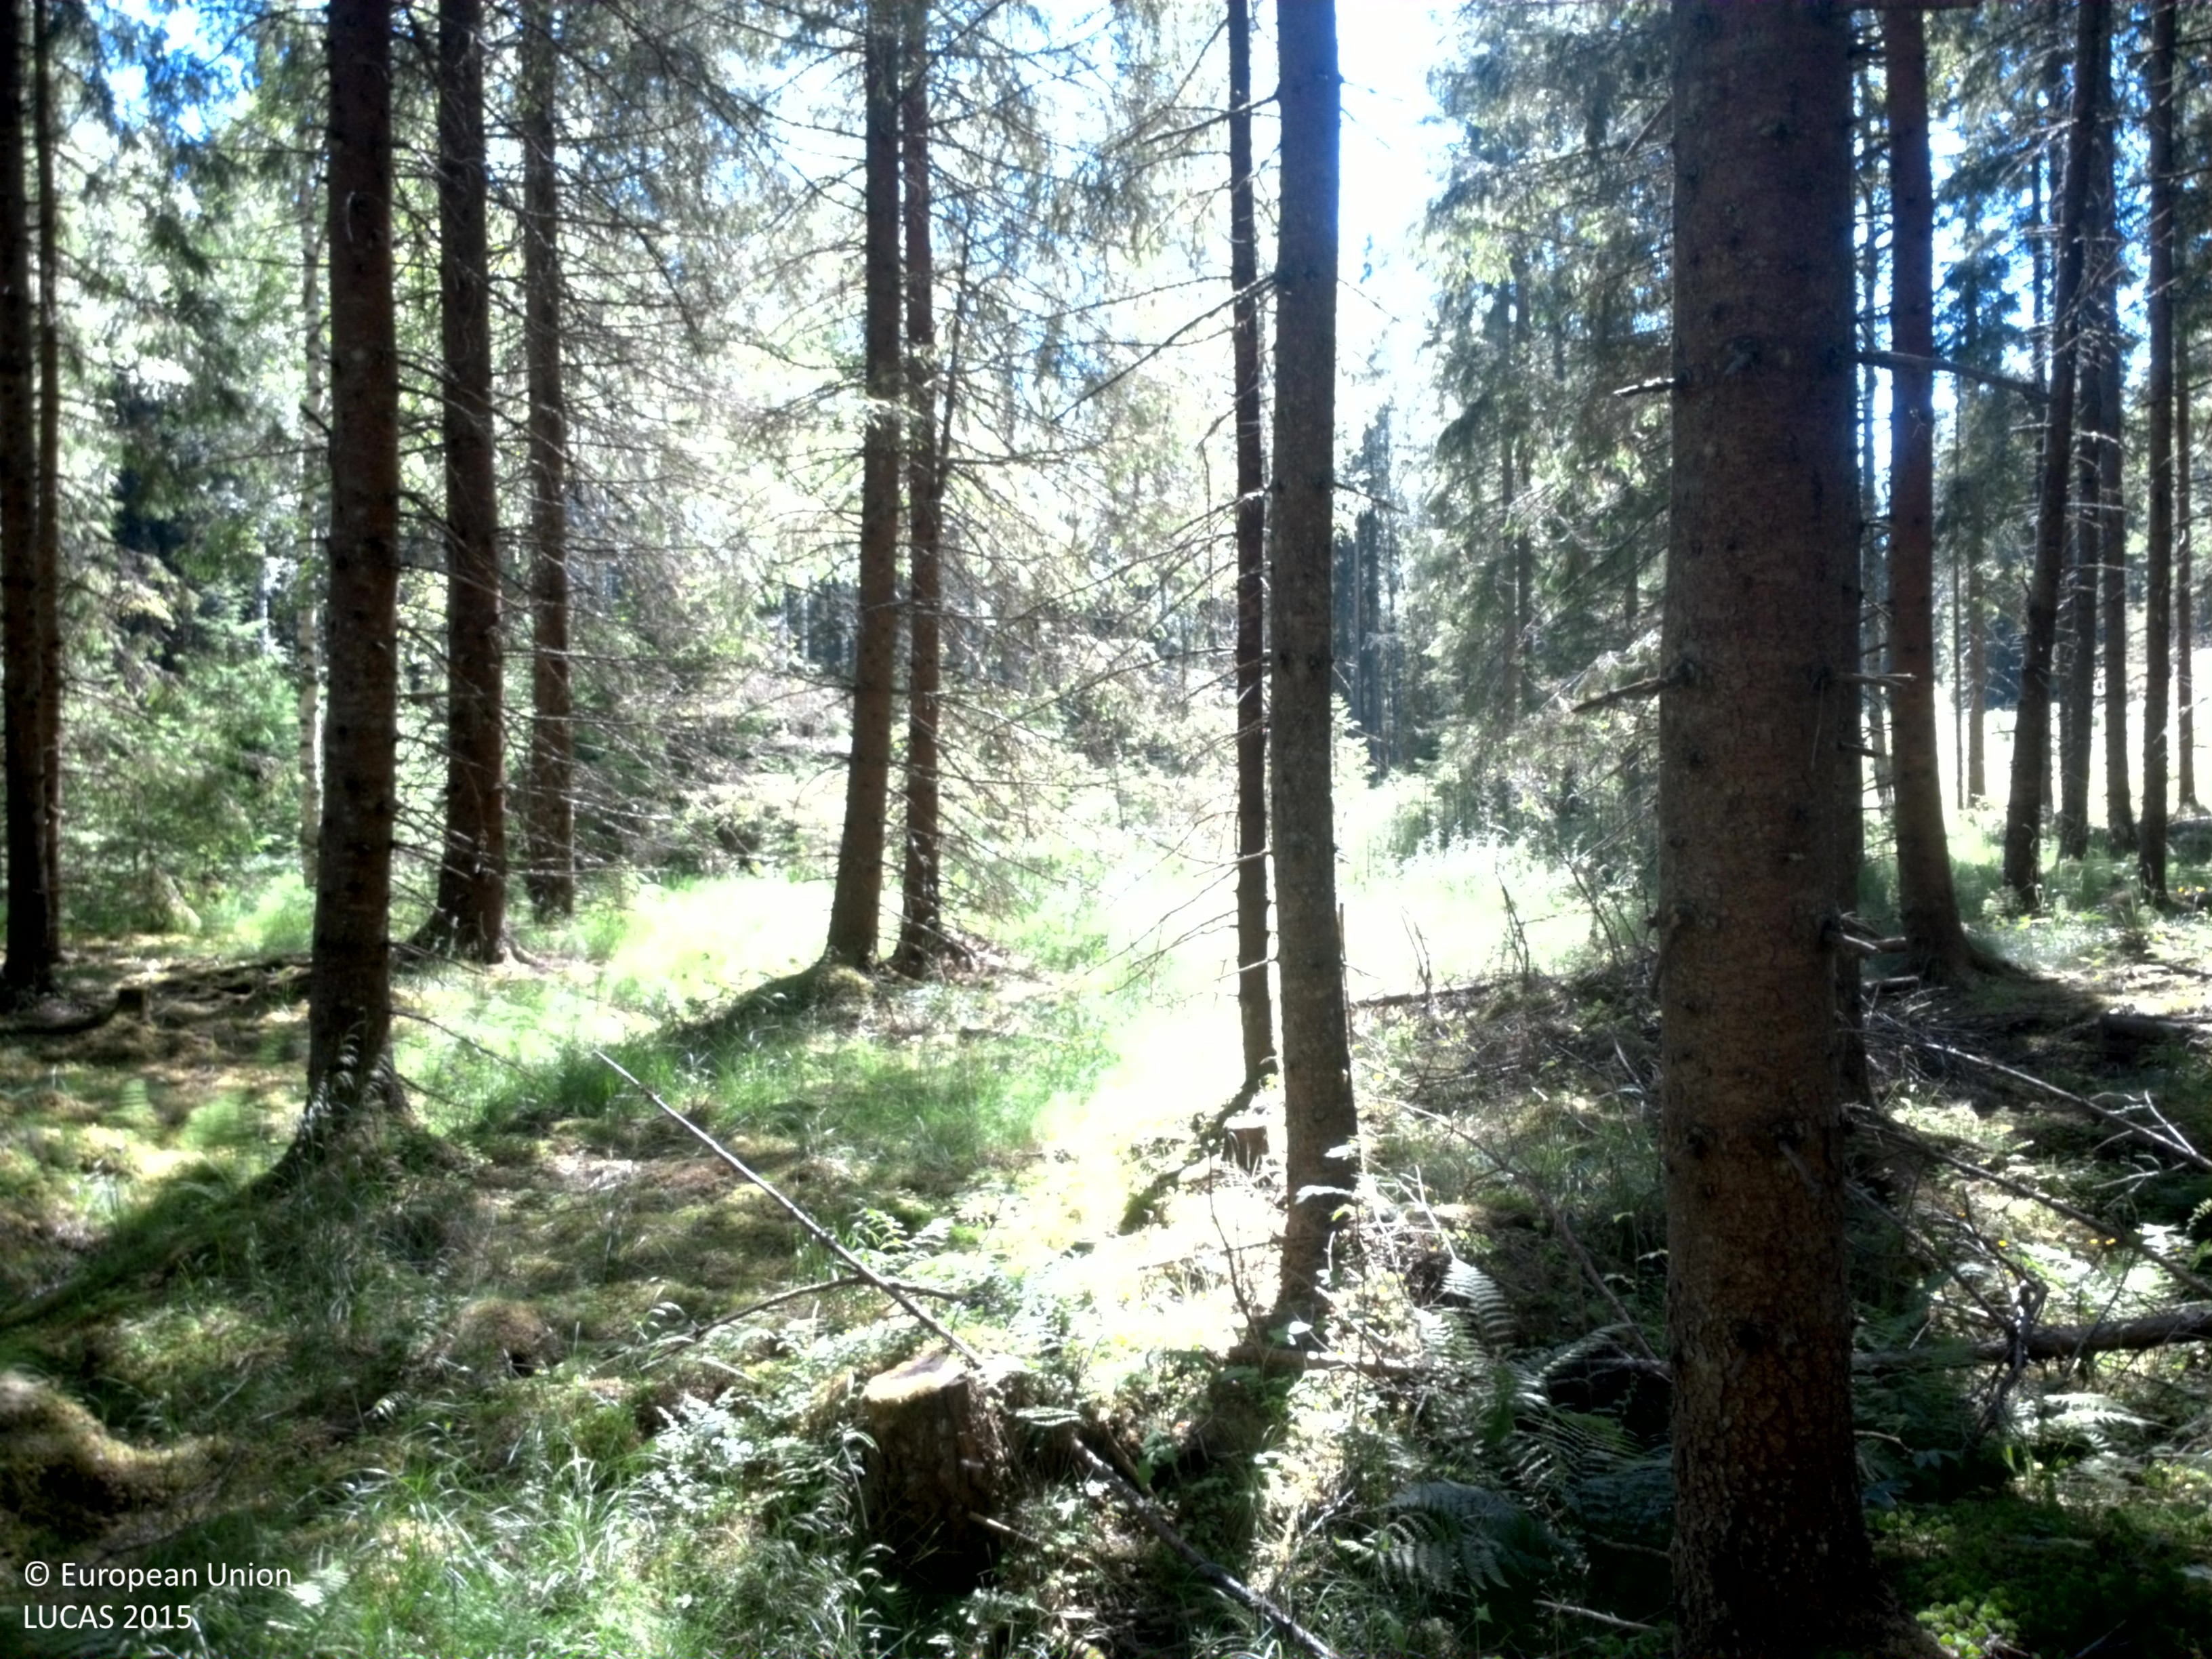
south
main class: Woodland
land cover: Spruce dominated coniferous woodland
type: boreal forest
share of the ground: 50 - 75 %
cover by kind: coniferous forest trees 70 %, lichens and mosses 15 %, broadleaved forest trees 5 %, shrubs 5 %, herbaceous plants 5 %
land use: Forestry
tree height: > 5 m
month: July
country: SE
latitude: 59.8422
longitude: 12.0108
